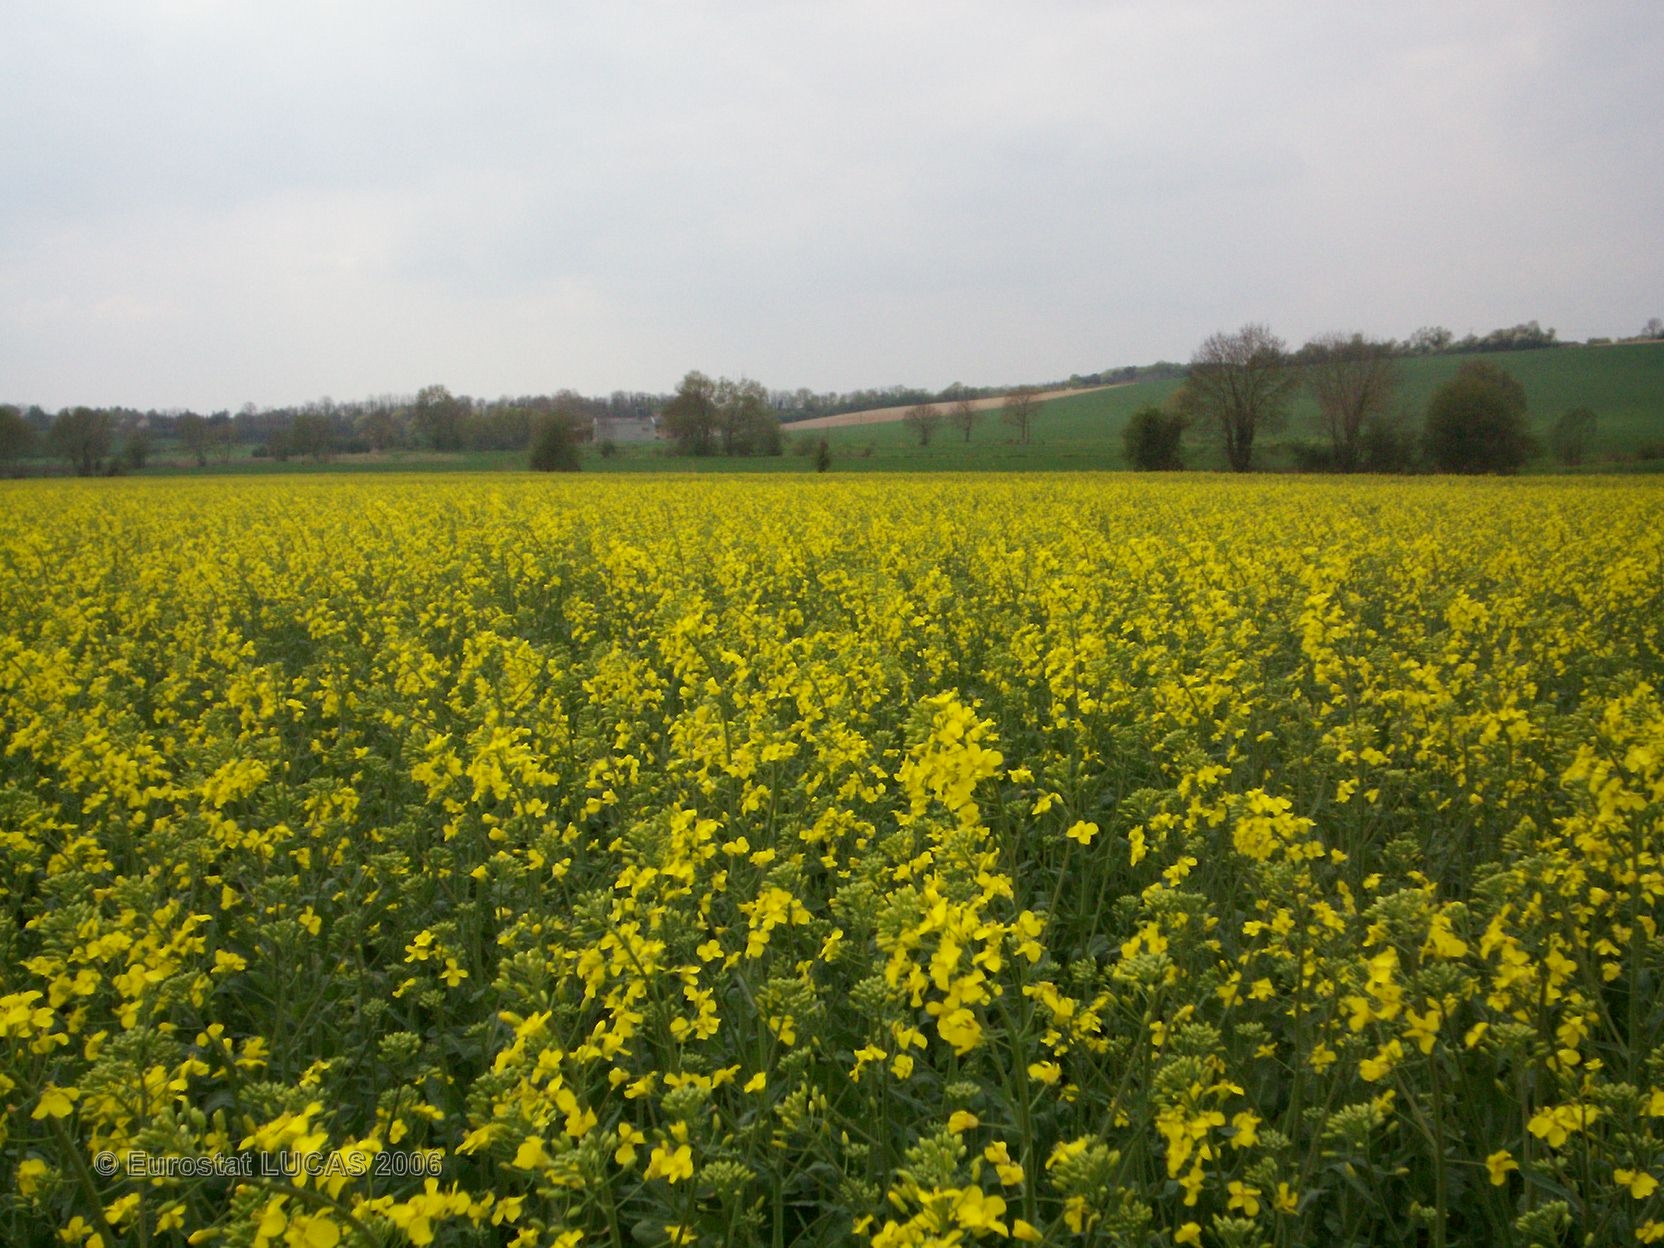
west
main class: Cropland
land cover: Rape and turnip rape
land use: Agriculture (excluding fallow land and kitchen gardens)
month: April
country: FR
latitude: 47.1548
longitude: 3.0447
